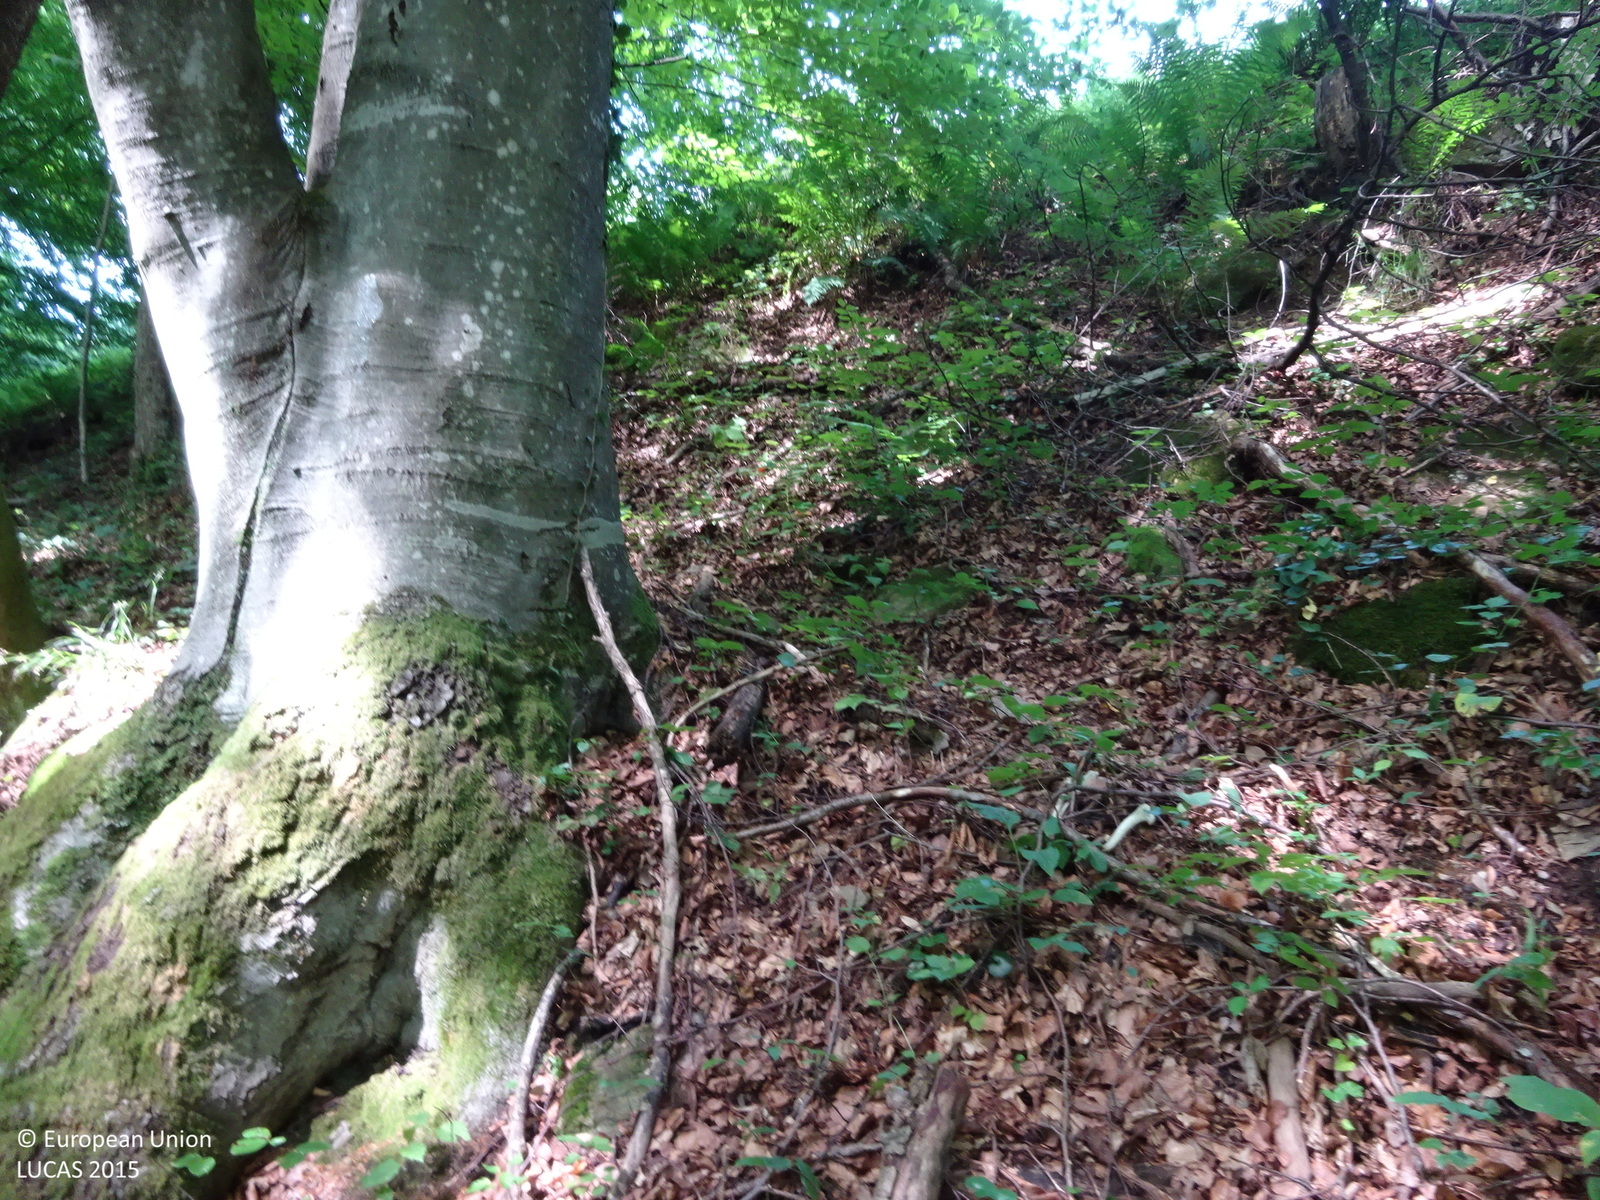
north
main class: Woodland
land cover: Broadleaved woodland
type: mountainous beech forest
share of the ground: > 75 %
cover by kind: broadleaved forest trees 100 %
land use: Forestry
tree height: > 5 m
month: July
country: AT
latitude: 46.7906
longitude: 15.4358
